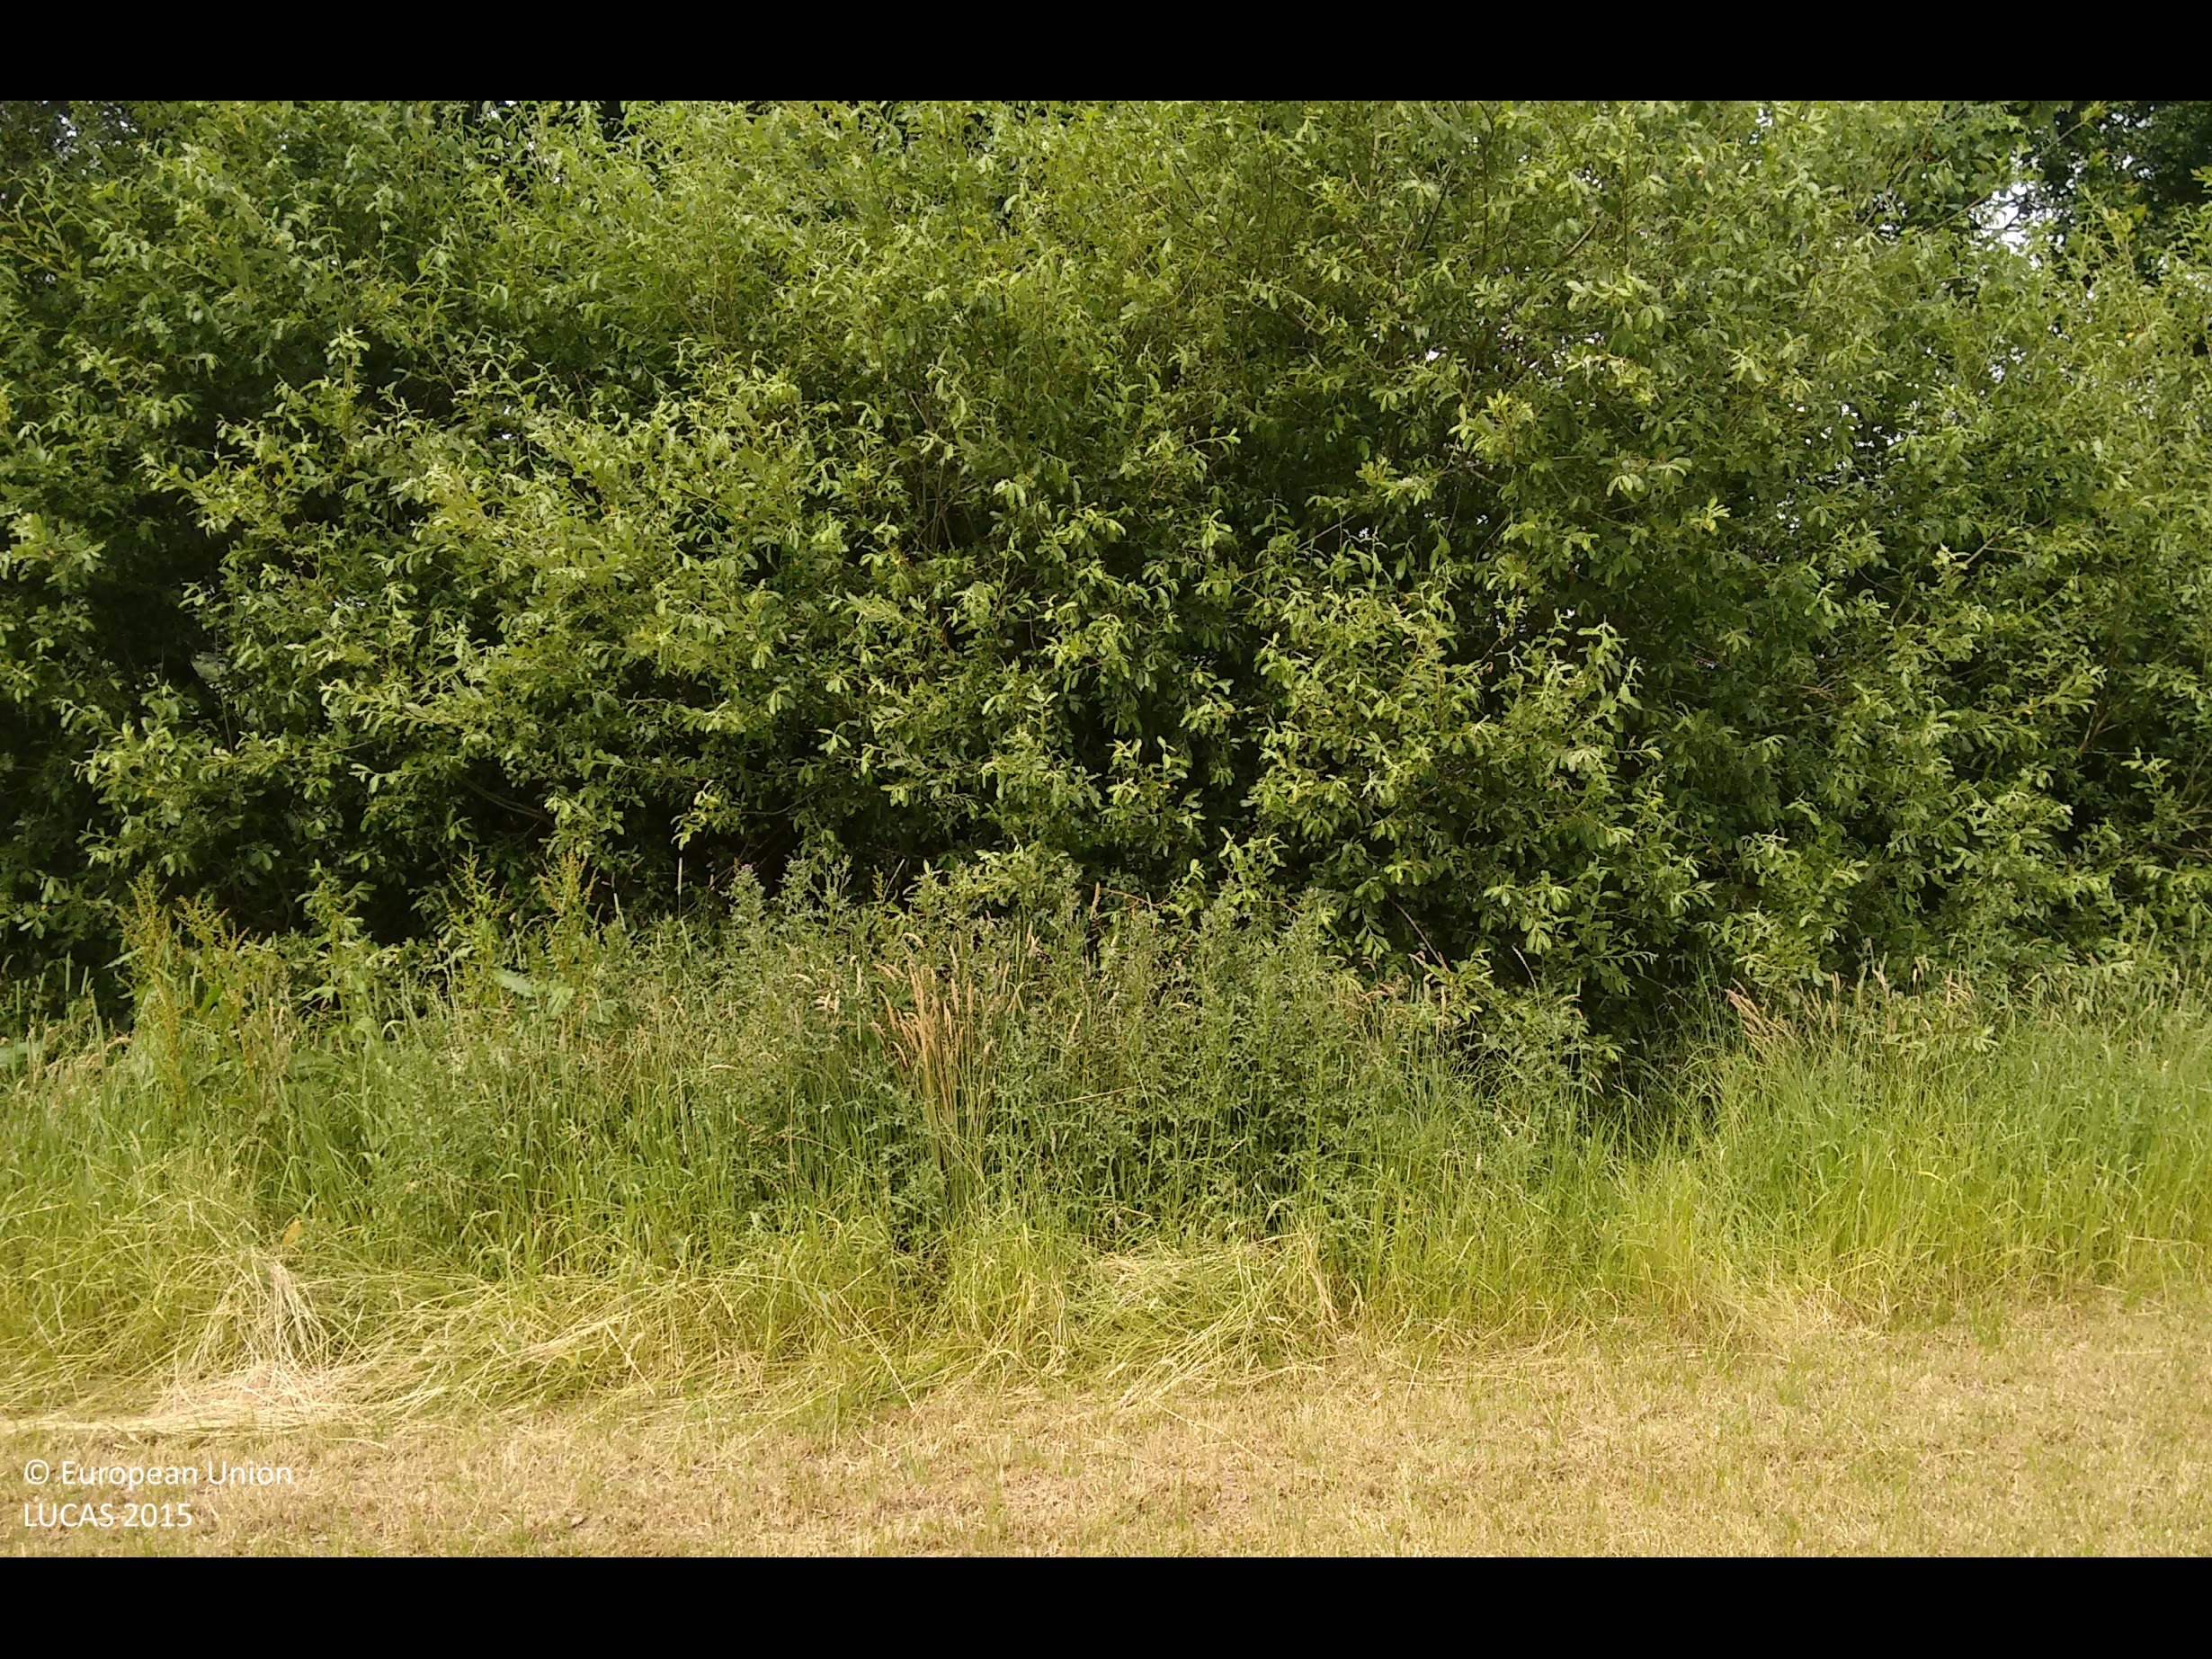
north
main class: Cropland
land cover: Temporary grasslands
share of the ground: > 75 %
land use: Agriculture (excluding fallow land and kitchen gardens)
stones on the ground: < 10 %
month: July
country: GB
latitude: 53.4381
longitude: -2.5457
